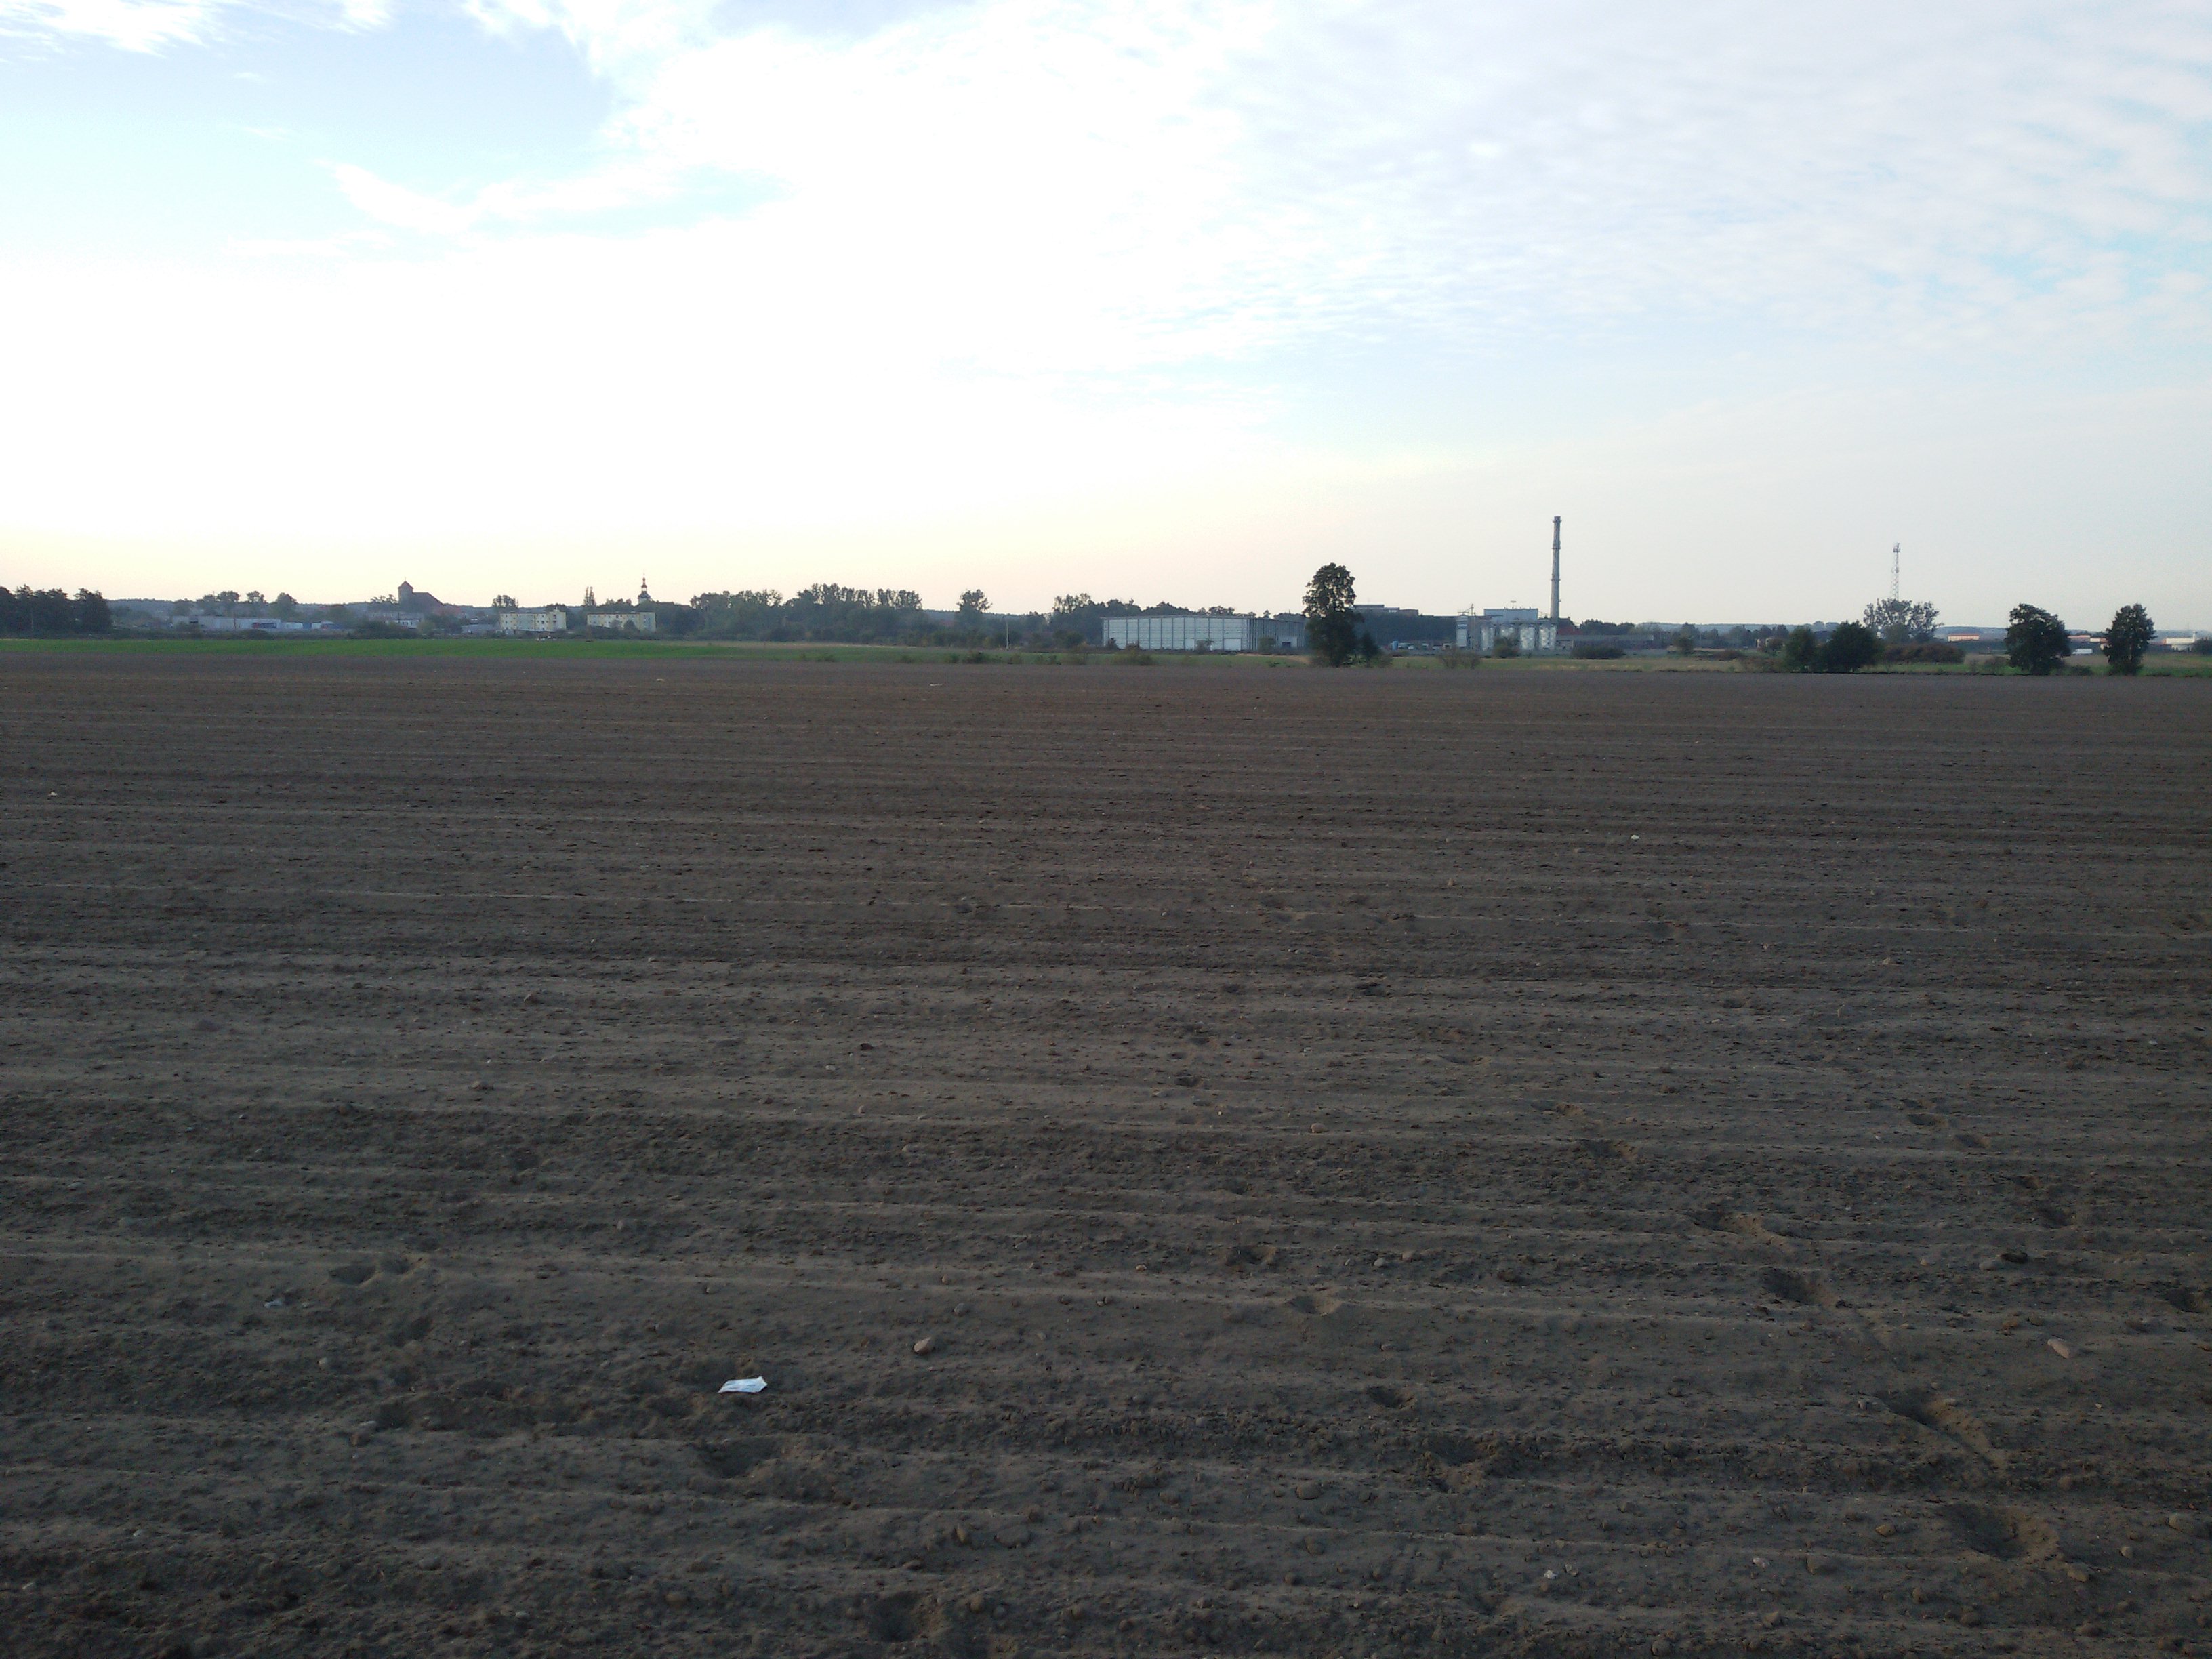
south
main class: Cropland
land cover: Rye
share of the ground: < 10 %
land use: Agriculture (excluding fallow land and kitchen gardens)
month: October
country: PL
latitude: 51.6608
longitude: 17.3704
